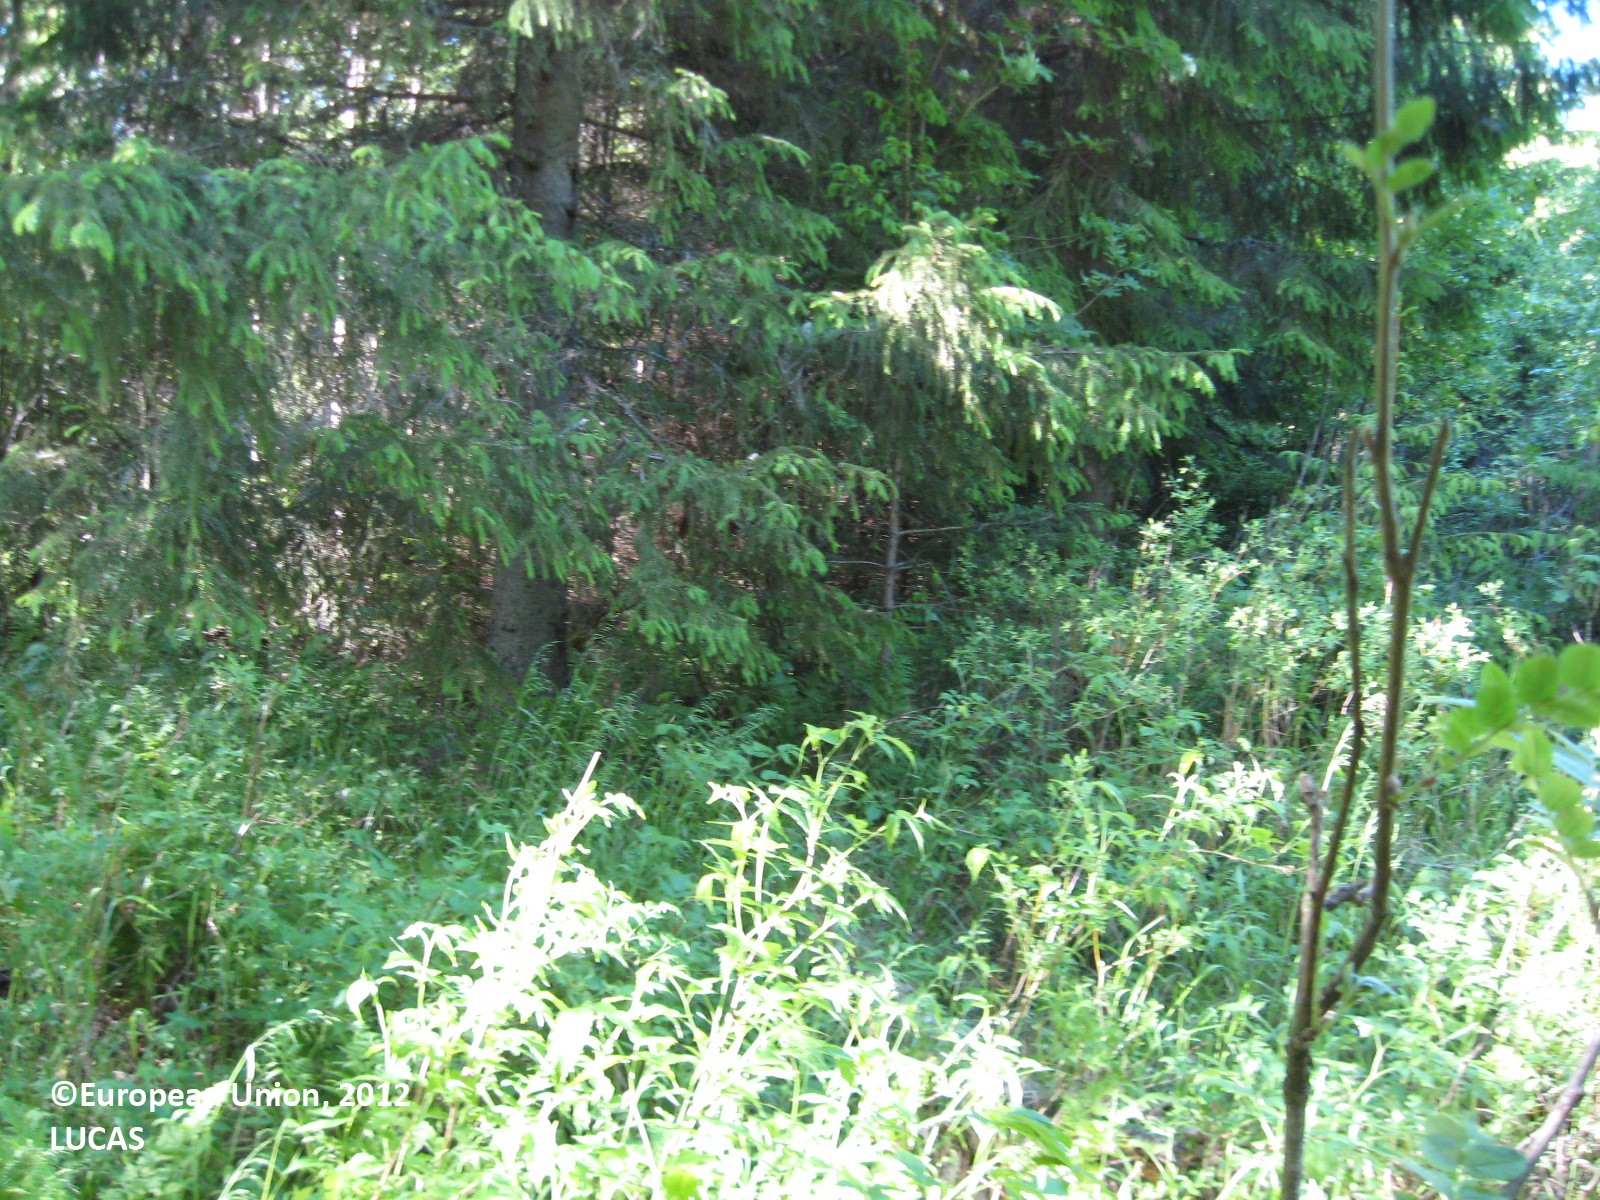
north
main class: Woodland
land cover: Other mixed woodland
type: boreal forest
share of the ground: > 75 %
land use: Forestry
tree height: > 5 m
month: June
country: FI
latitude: 62.9676
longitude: 21.8172
